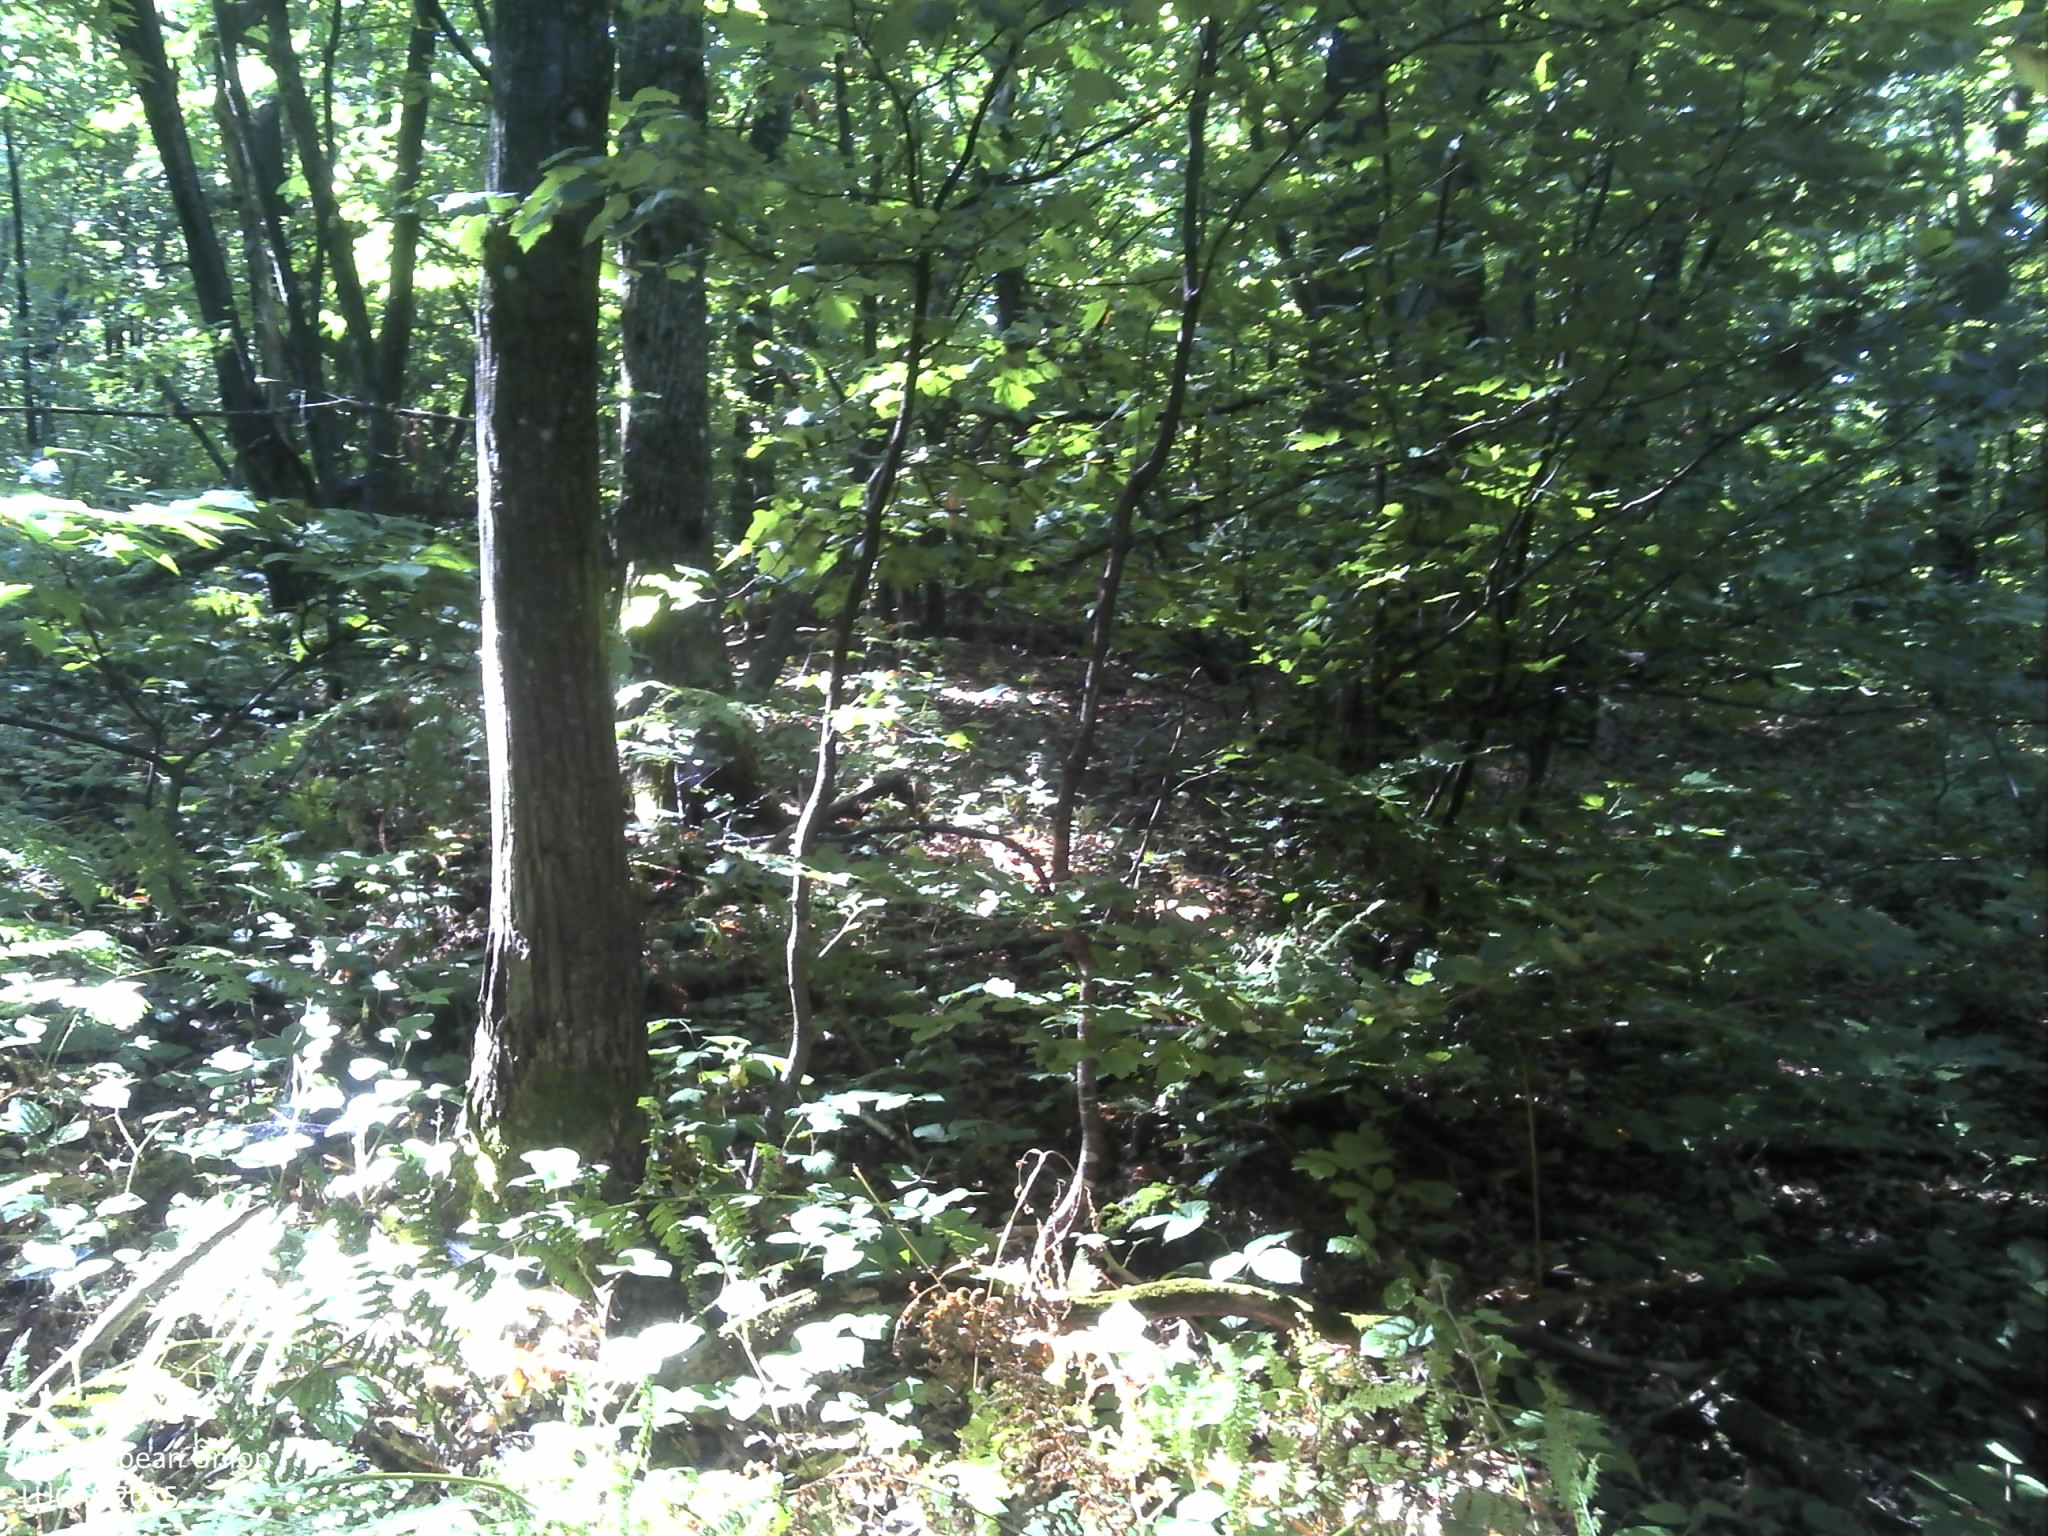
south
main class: Woodland
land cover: Broadleaved woodland
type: beech forest
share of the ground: > 75 %
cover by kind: broadleaved forest trees 100 %
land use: Forestry
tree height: > 5 m
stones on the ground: < 10 %
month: August
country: HR
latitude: 45.2048
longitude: 16.3498
